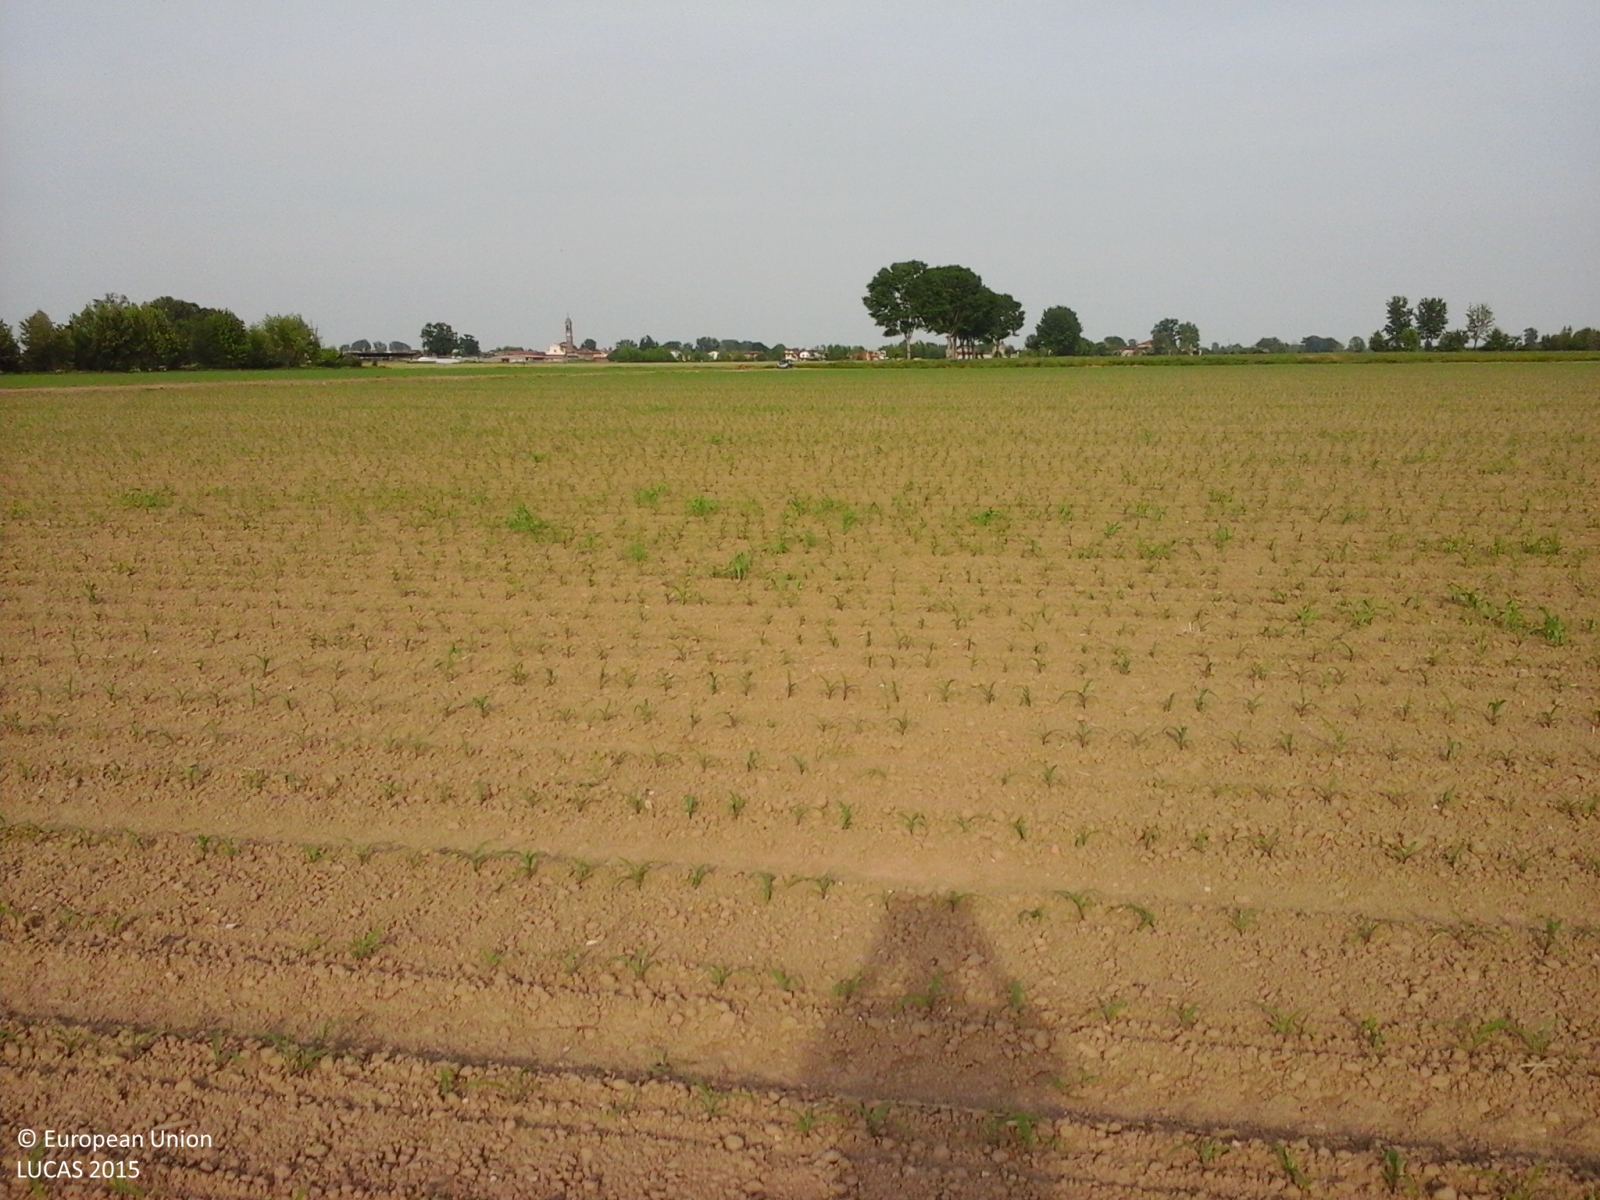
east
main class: Cropland
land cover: Temporary grasslands
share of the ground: > 75 %
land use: Agriculture (excluding fallow land and kitchen gardens)
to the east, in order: Temporary grasslands; Grass margins; Ditches and canals; Maize
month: May
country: IT
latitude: 45.2160
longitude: 10.0127
